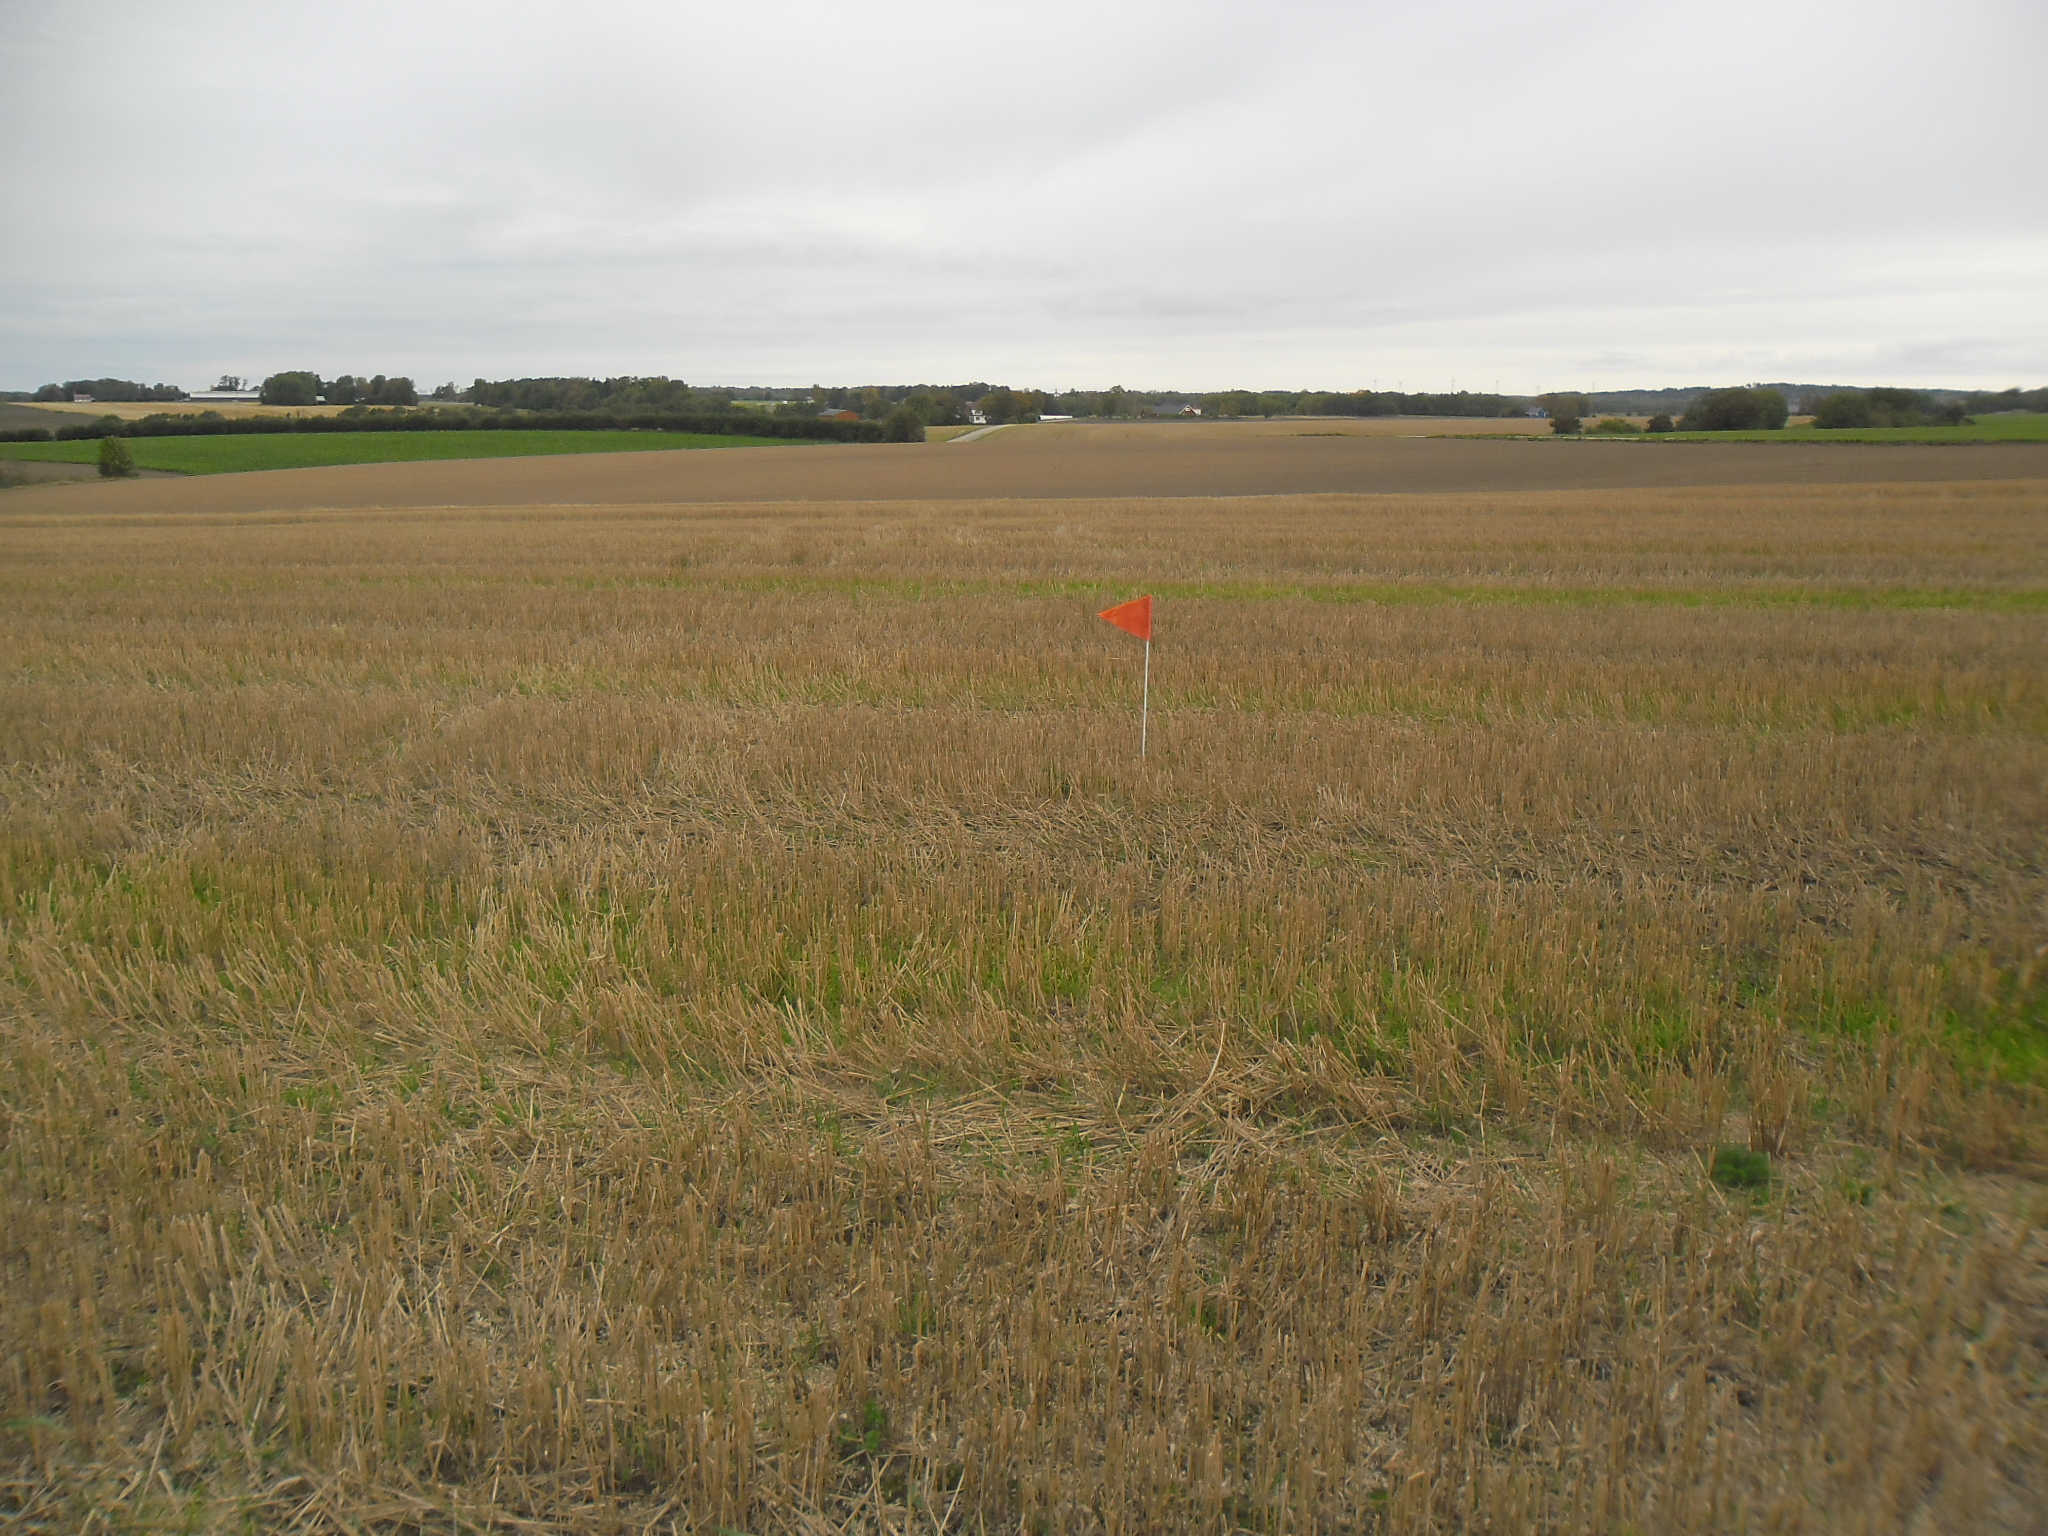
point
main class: Cropland
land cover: Common wheat
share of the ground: 10 - 25 %
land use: Agriculture (excluding fallow land and kitchen gardens)
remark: Harvested field
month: October
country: SE
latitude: 56.4743
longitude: 13.0978
